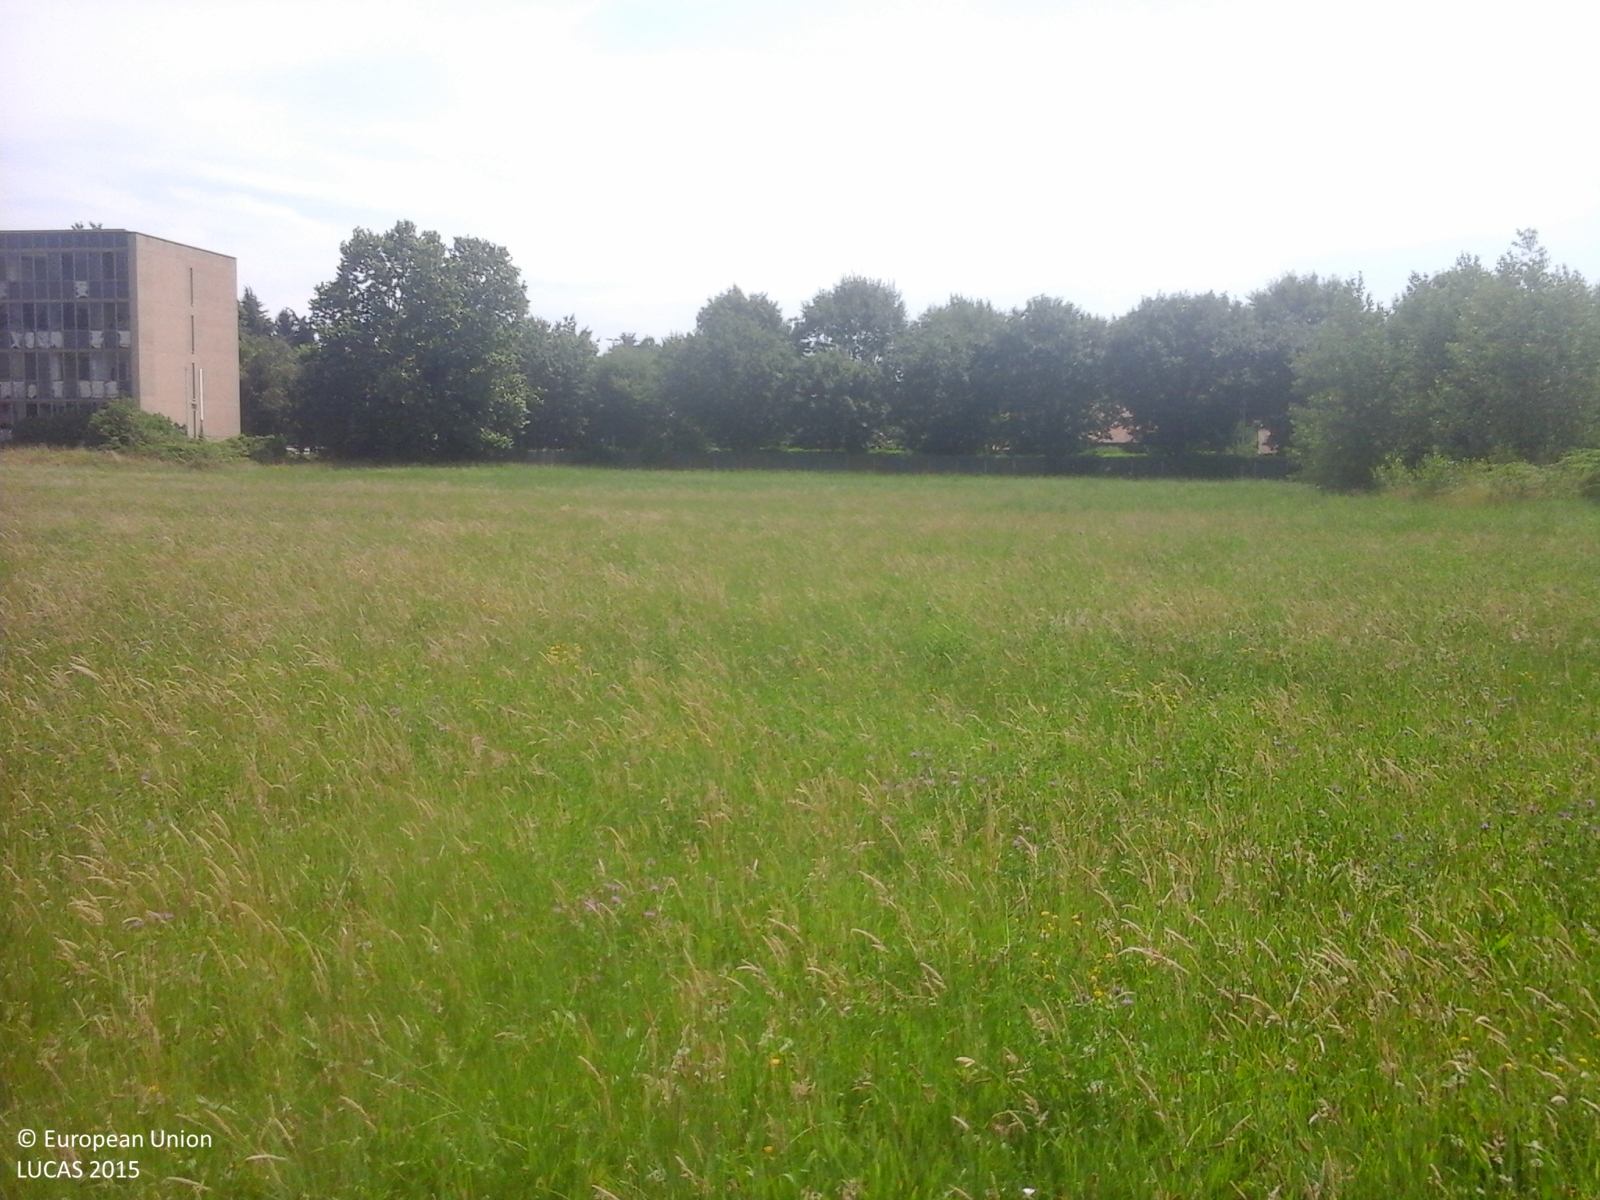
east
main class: Grassland
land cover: Grassland without tree/shrub cover
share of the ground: > 75 %
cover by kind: herbaceous plants 100 %
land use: Logistics and storage
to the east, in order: Grassland without tree/shrub cover; Artificial constructions in urban areas
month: June
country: IT
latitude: 45.6467
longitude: 9.3723
